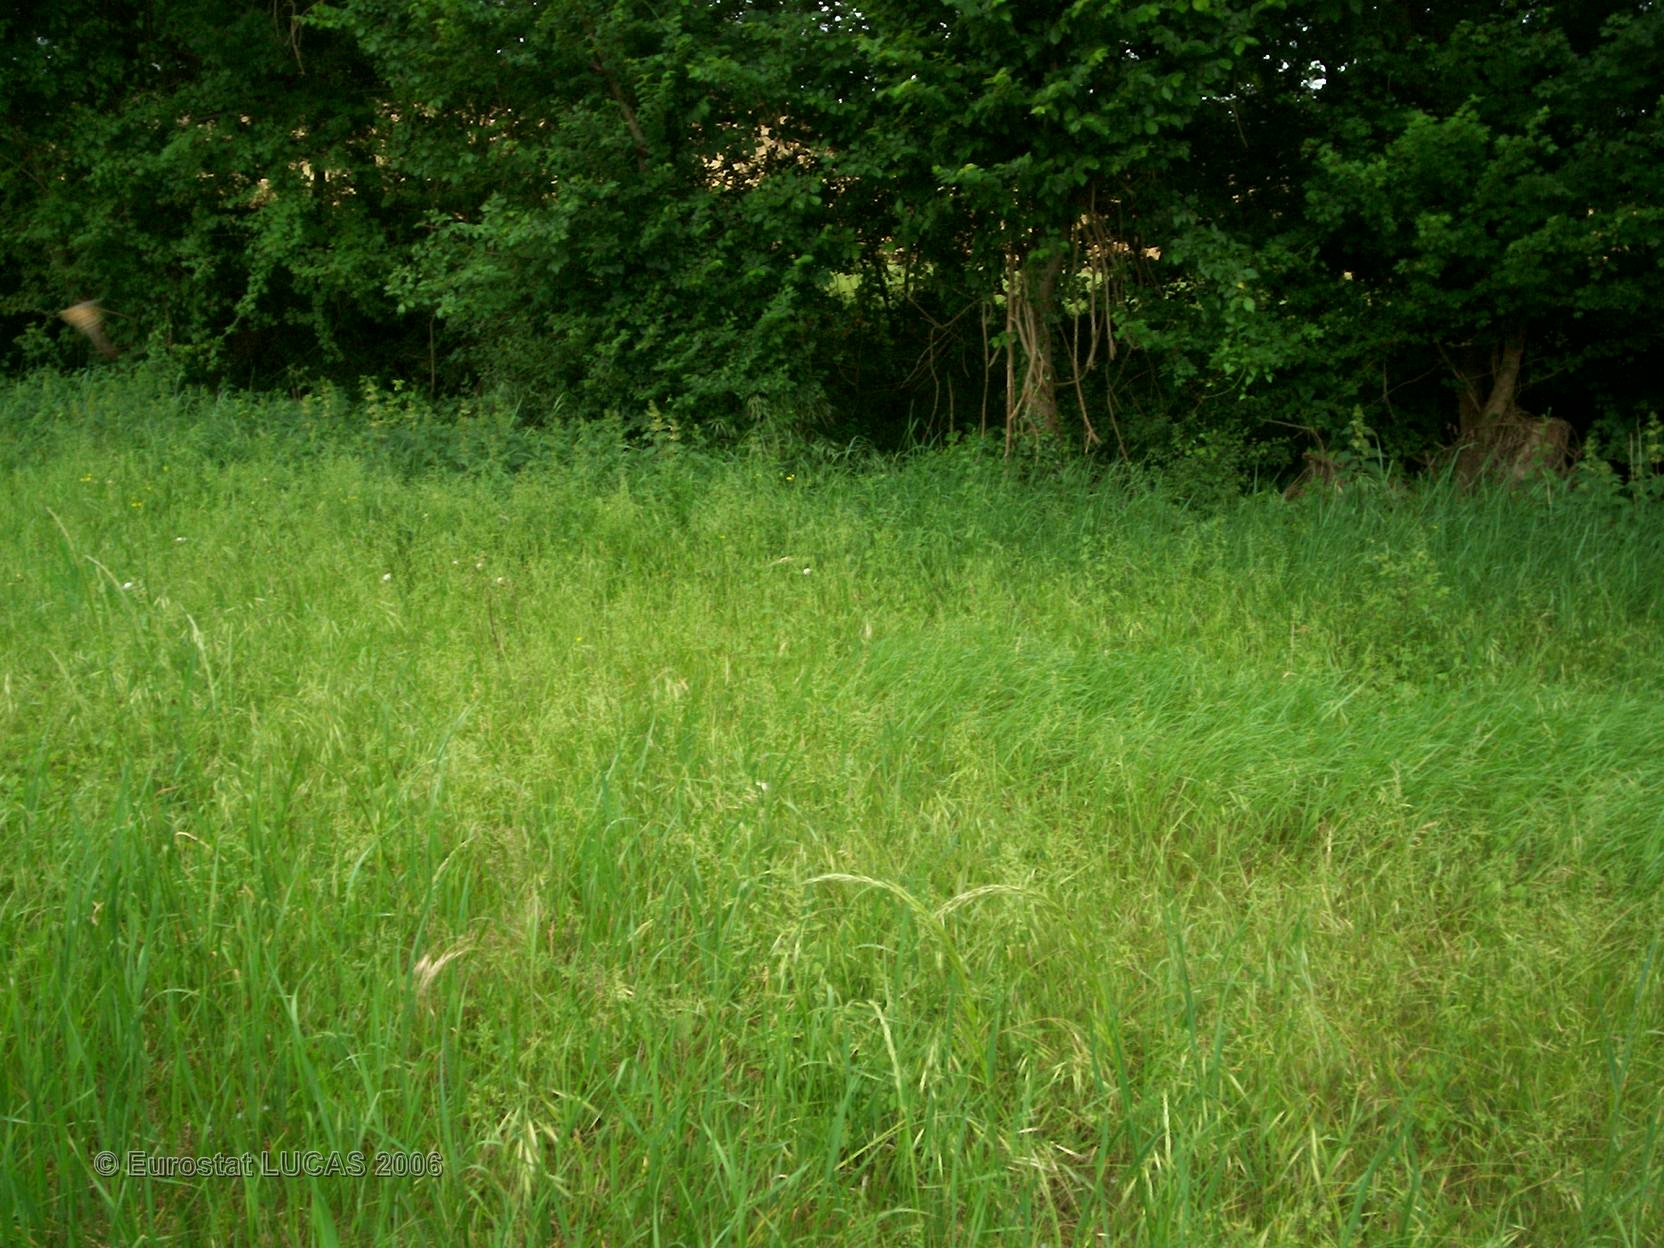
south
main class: Grassland
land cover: Grassland without tree/shrub cover
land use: Agriculture (excluding fallow land and kitchen gardens)
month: May
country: FR
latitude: 43.5282
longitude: 1.0552
